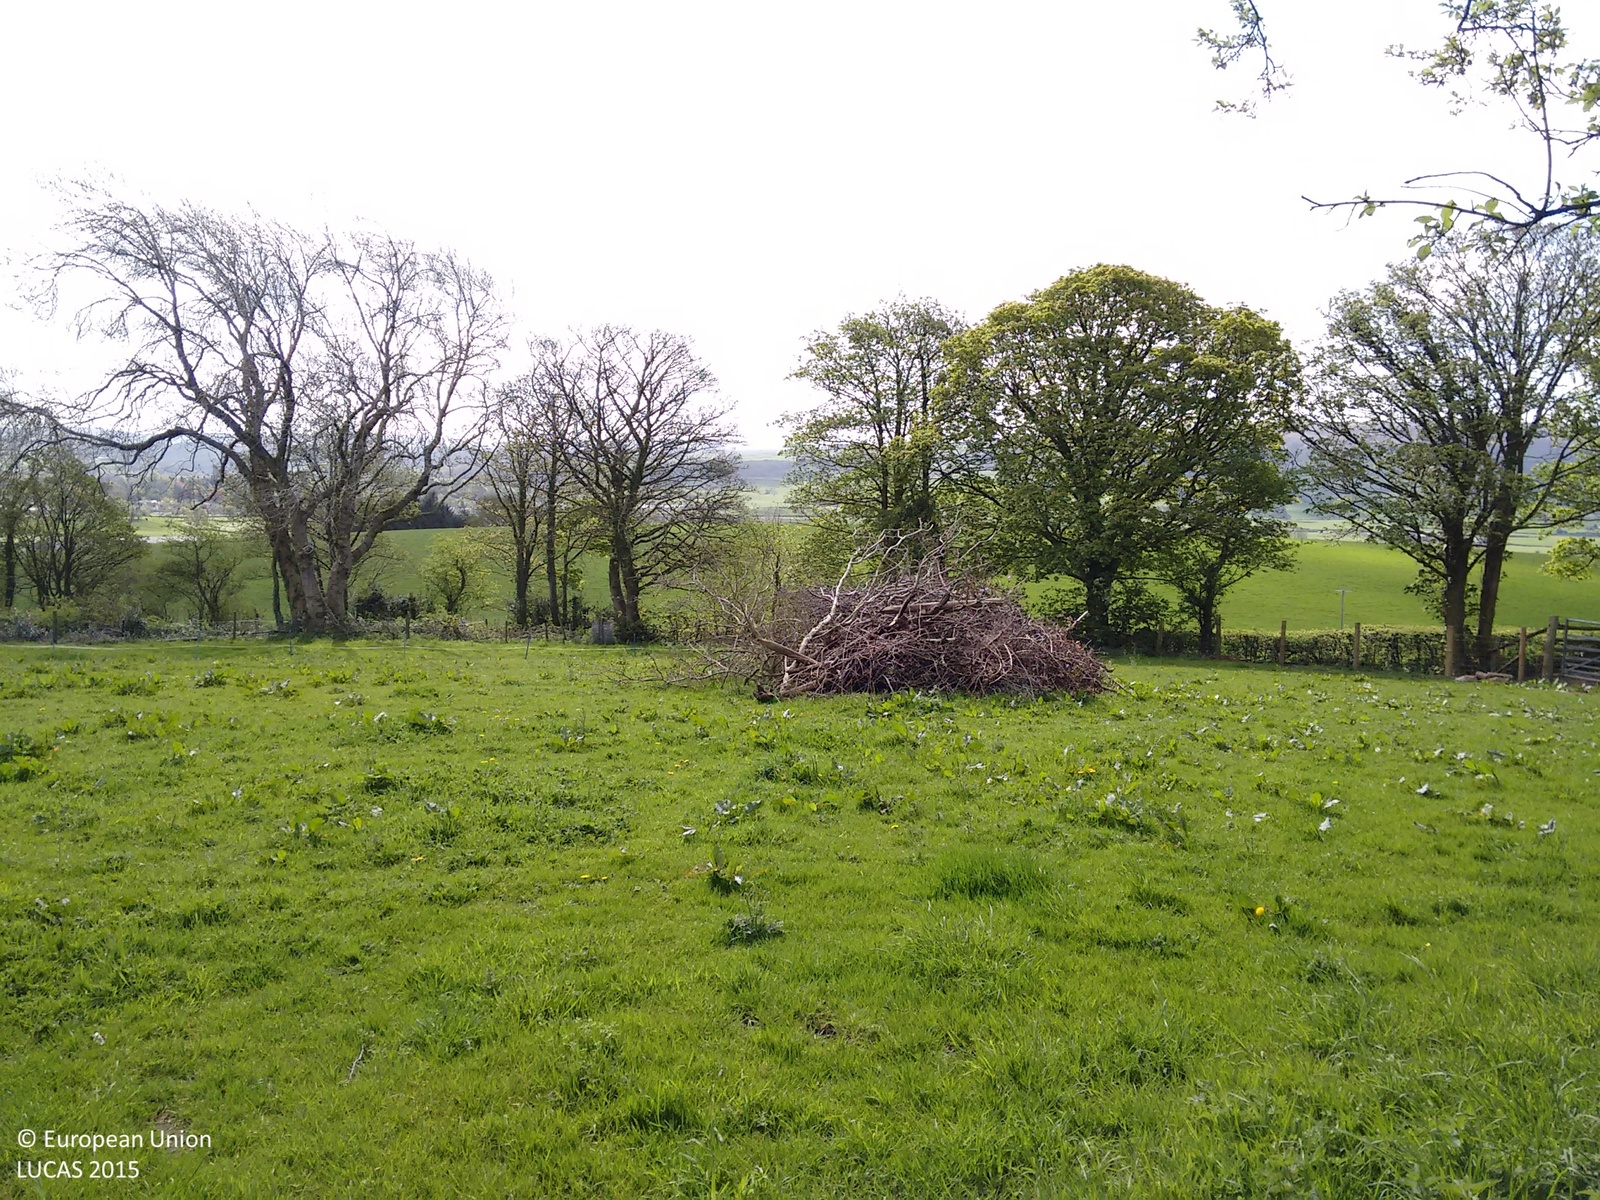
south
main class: Grassland
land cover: Grassland without tree/shrub cover
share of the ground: > 75 %
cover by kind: herbaceous plants 100 %
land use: Agriculture (excluding fallow land and kitchen gardens)
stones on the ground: < 10 %
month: May
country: GB
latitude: 54.1184
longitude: -2.6584
